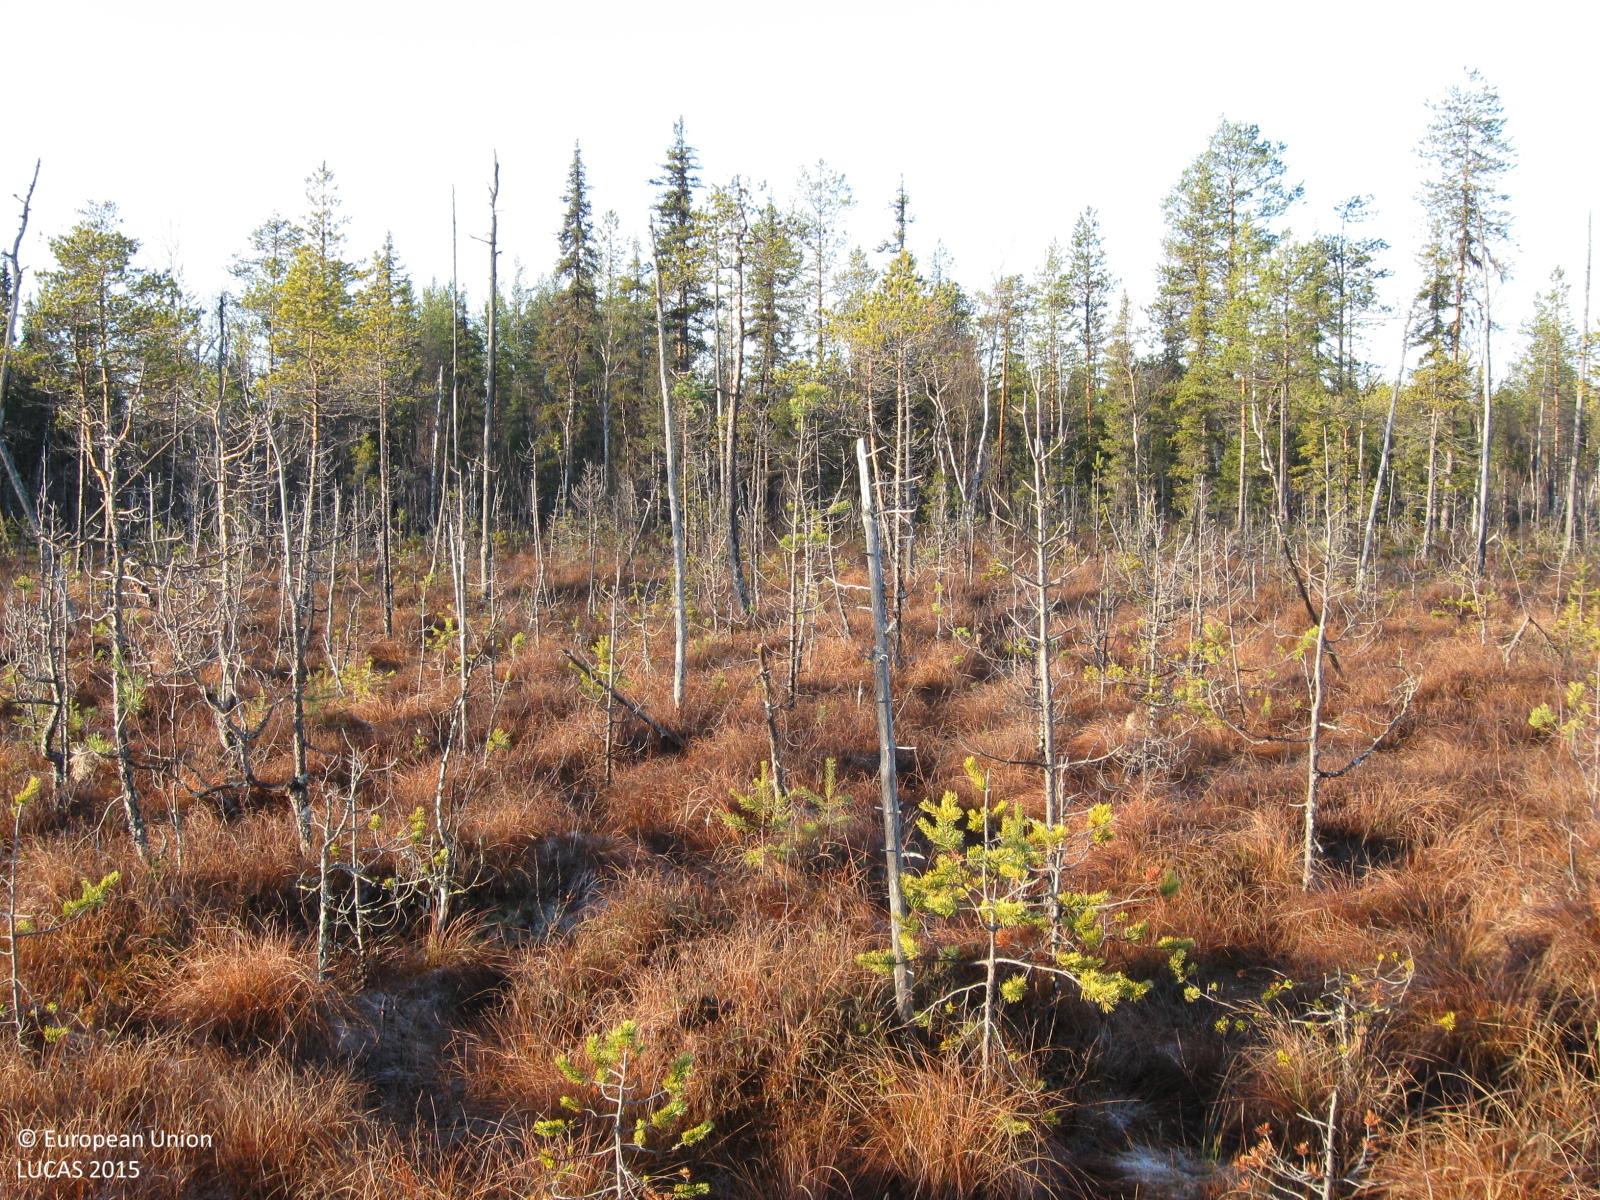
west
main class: Woodland
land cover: Pine dominated coniferous woodland
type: mire and swamp forests
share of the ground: 10 - 25 %
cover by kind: herbaceous plants 55 %, coniferous forest trees 20 %, lichens and mosses 15 %, shrubs 10 %
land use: Semi-natural and natural areas not in use
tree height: < 5 m
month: October
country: SE
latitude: 66.2531
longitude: 20.8879
